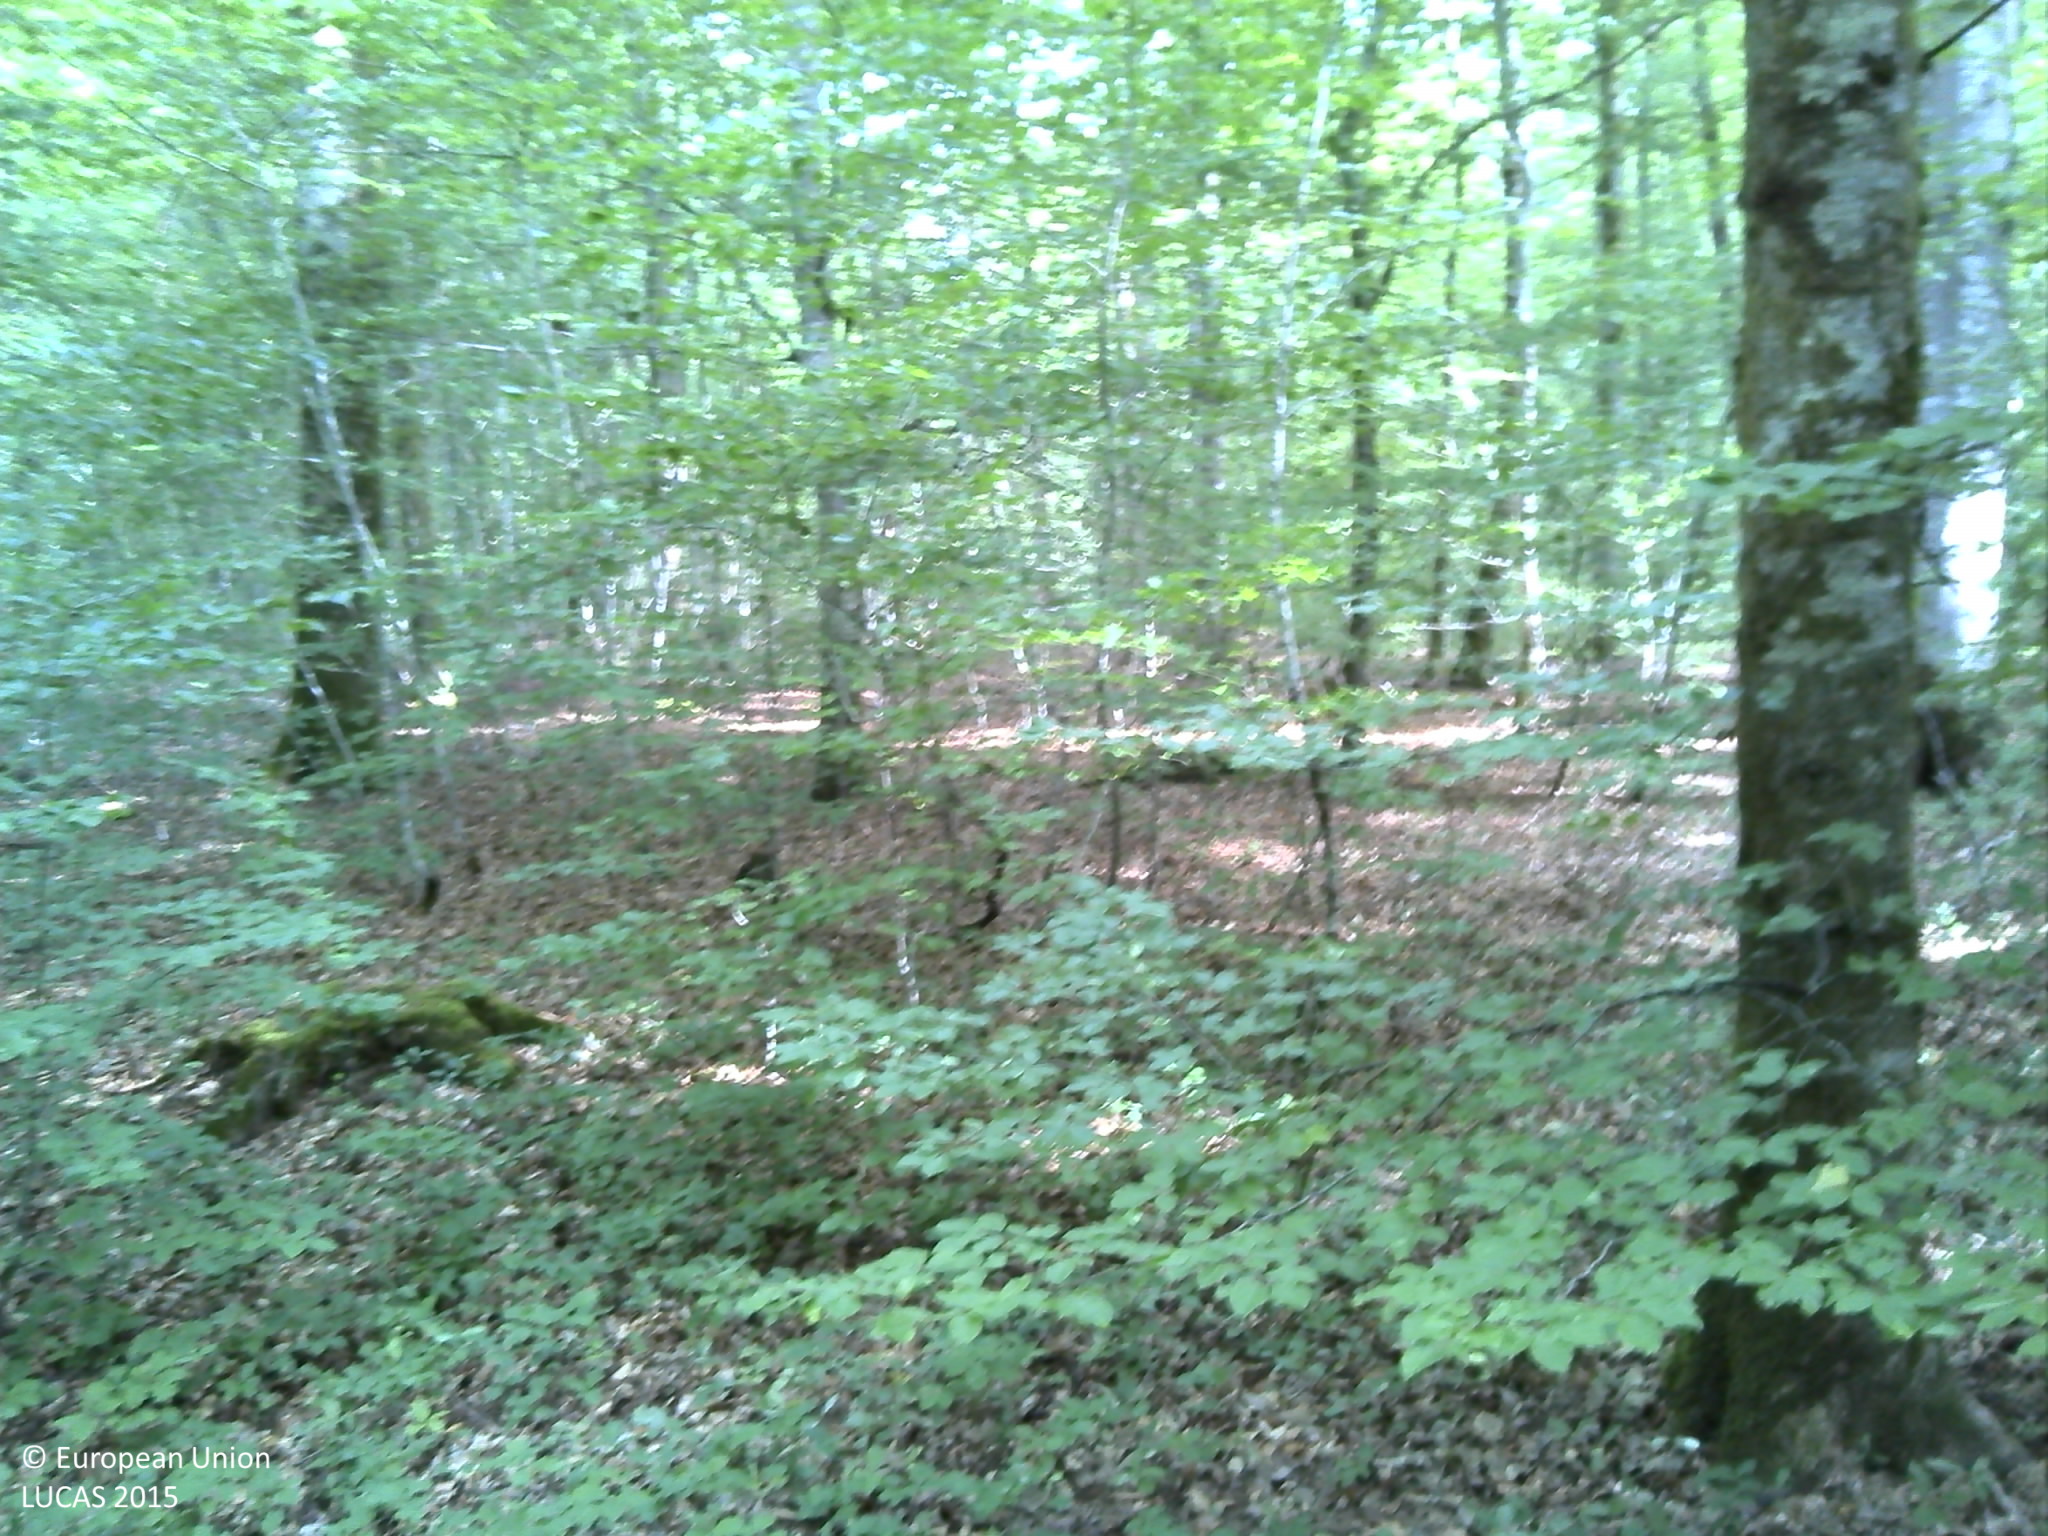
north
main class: Woodland
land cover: Broadleaved woodland
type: acidophilous oak and oak-birch forest
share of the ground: > 75 %
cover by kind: broadleaved forest trees 90 %, herbaceous plants 5 %, unconsolidated bare surface 5 %
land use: Forestry
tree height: > 5 m
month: July
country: FR
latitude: 48.0076
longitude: 6.0194
